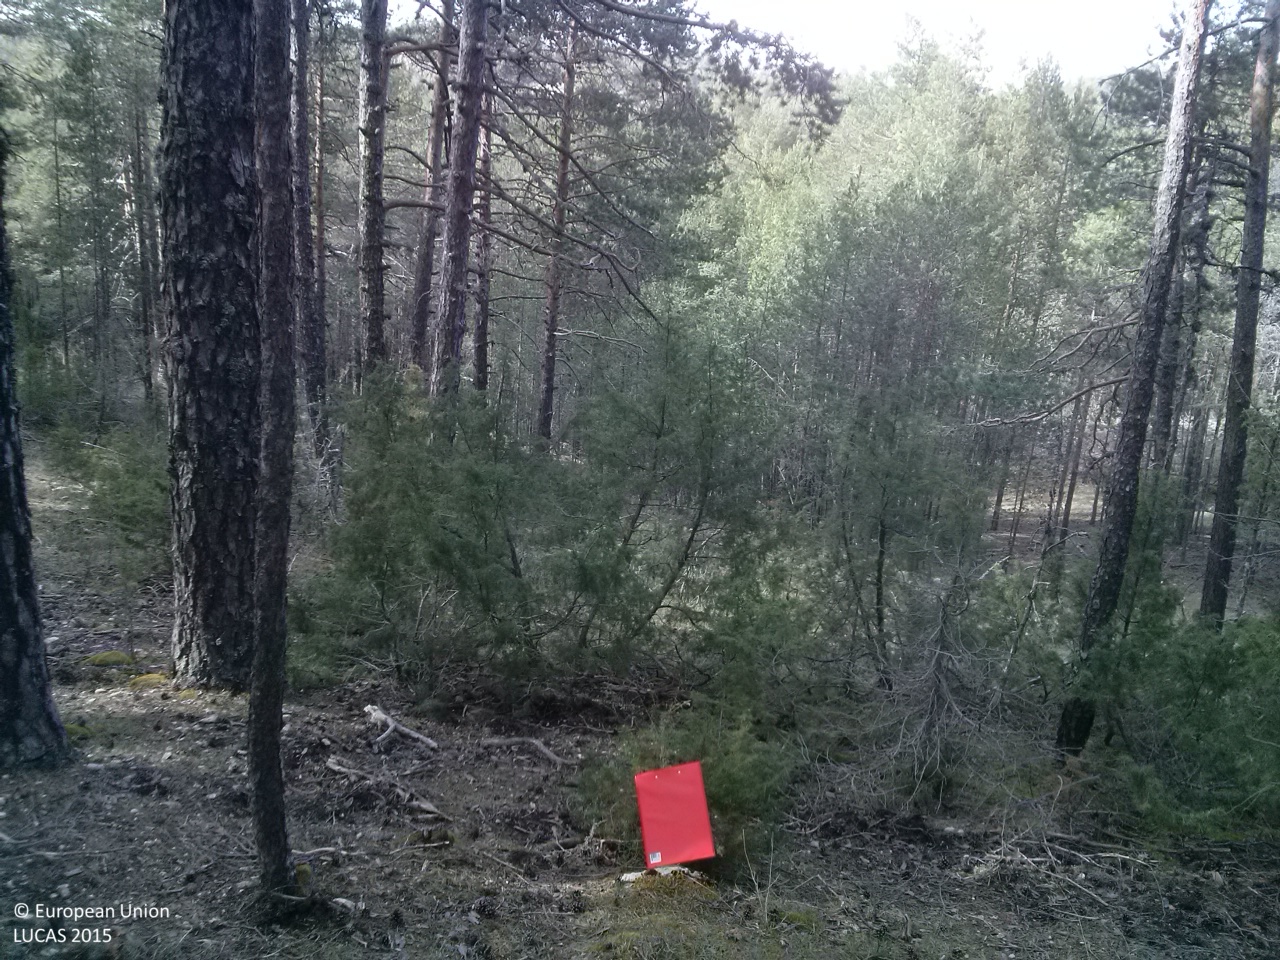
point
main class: Woodland
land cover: Pine dominated coniferous woodland
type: coniferous forest of the mediterranean region
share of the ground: > 75 %
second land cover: Grassland without tree/shrub cover
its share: 10 - 25 %
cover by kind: coniferous forest trees 90 %, herbaceous plants 10 %
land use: Forestry
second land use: Agriculture (excluding fallow land and kitchen gardens)
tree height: > 5 m
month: April
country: ES
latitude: 40.2938
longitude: -1.8621
